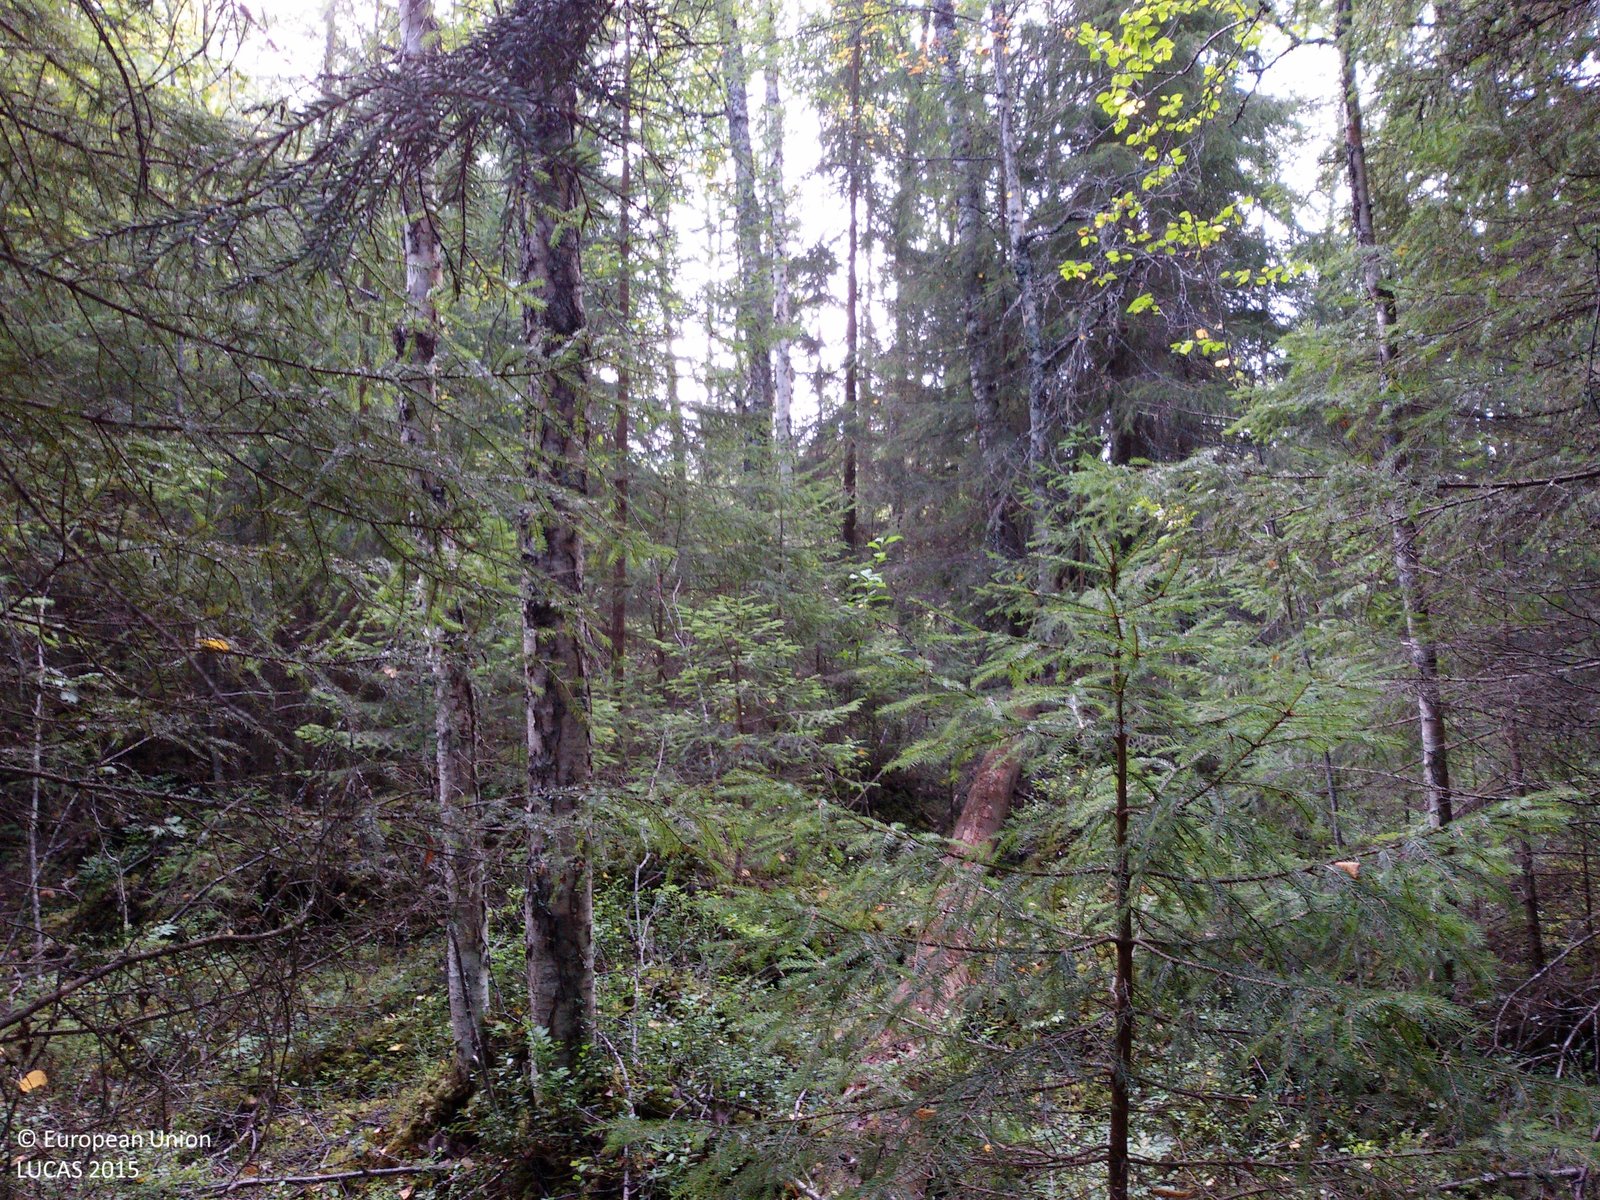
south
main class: Woodland
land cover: Spruce dominated coniferous woodland
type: boreal forest
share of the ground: > 75 %
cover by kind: coniferous forest trees 90 %, lichens and mosses 10 %
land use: Forestry
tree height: > 5 m
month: September
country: SE
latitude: 60.9454
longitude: 15.3577
